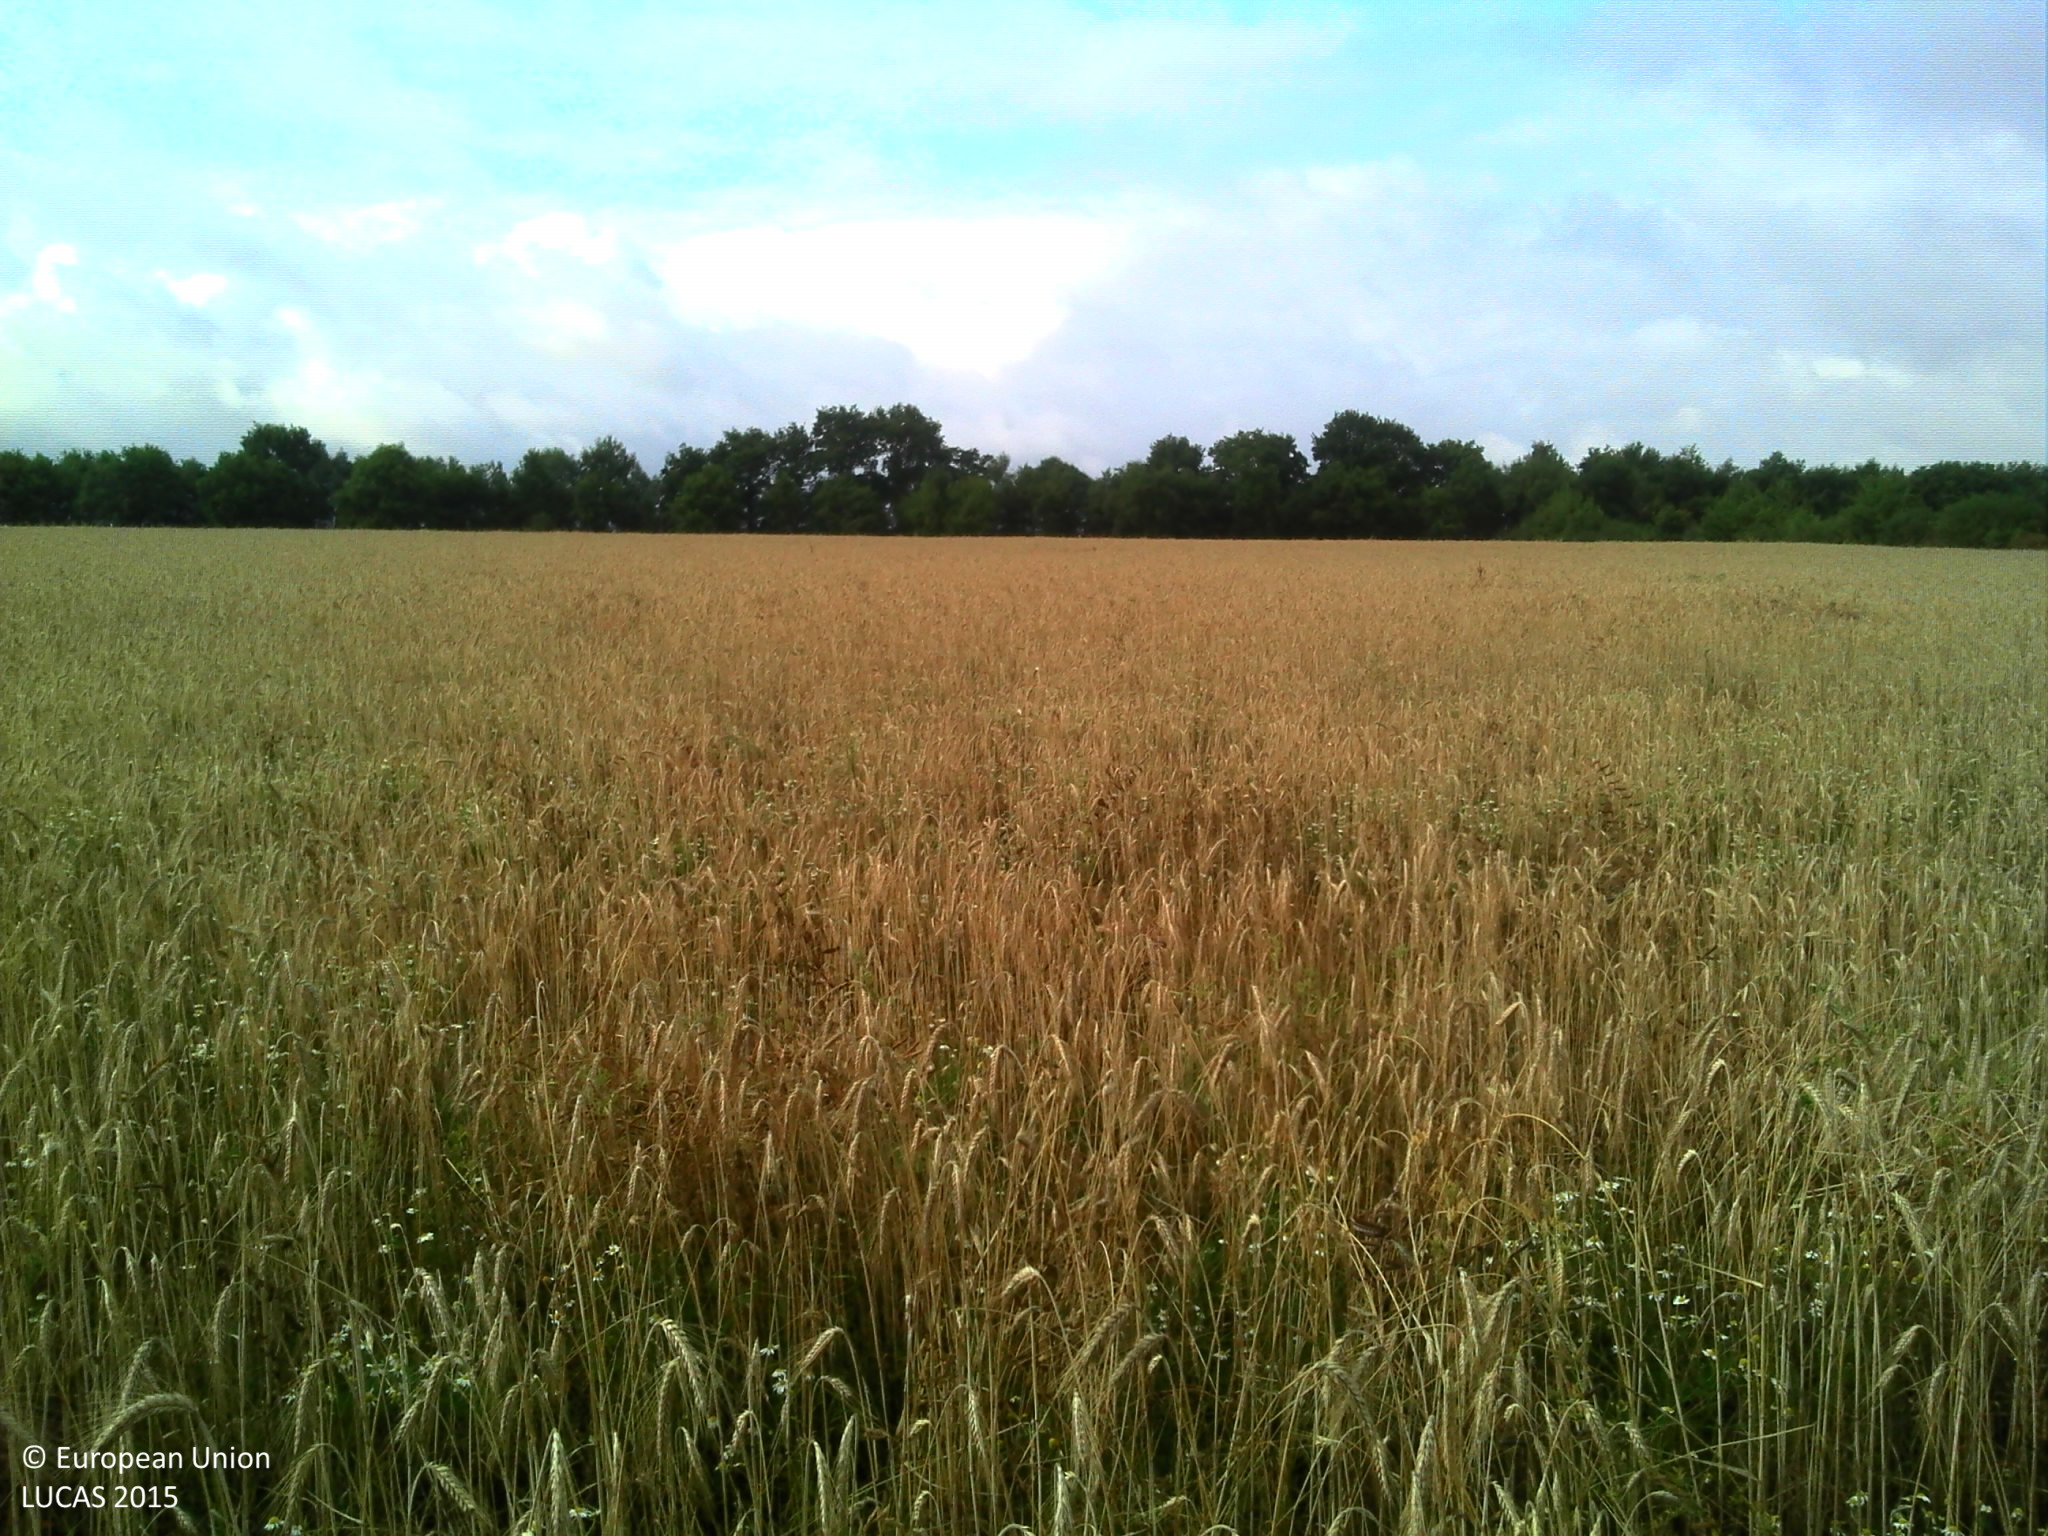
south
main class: Cropland
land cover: Common wheat
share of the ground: > 75 %
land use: Agriculture (excluding fallow land and kitchen gardens)
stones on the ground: 10 - 25 %
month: July
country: FR
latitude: 47.5032
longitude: -1.9037
